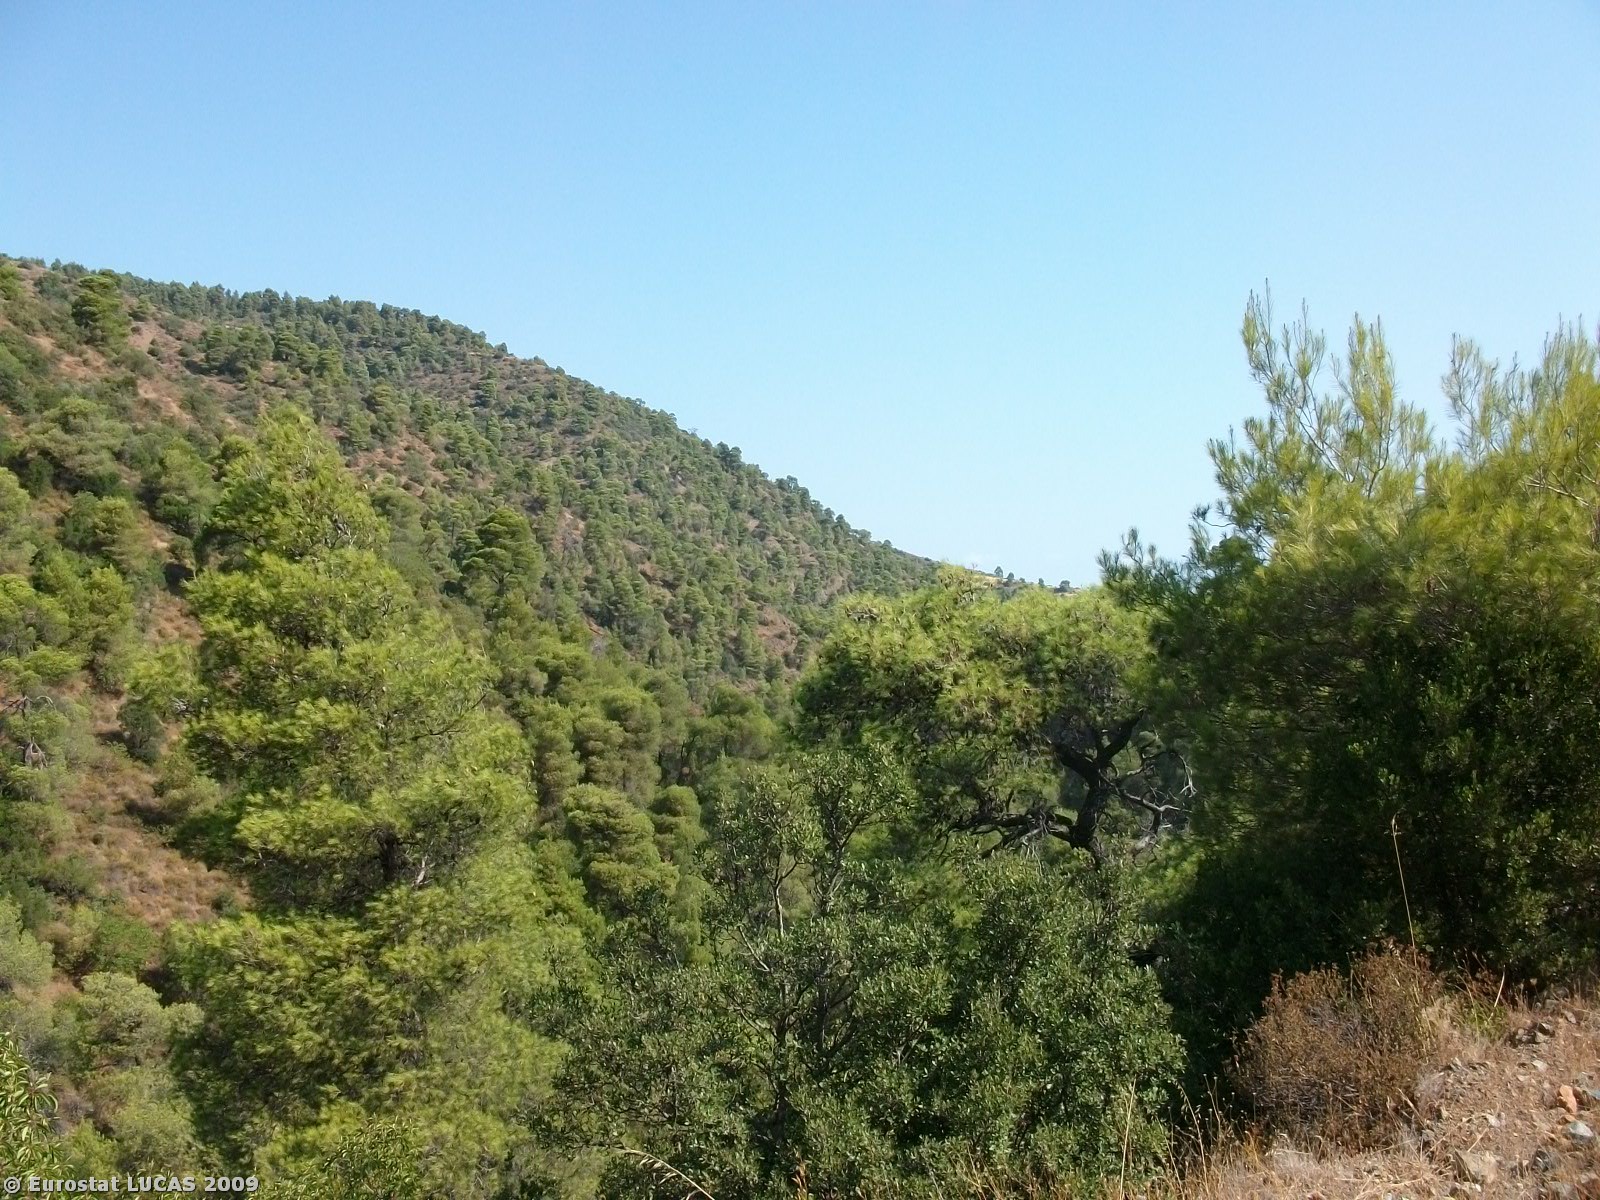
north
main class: Shrubland
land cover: Shrubland with sparse tree cover
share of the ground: 50 - 75 %
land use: Unused
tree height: < 5 m
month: August
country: GR
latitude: 38.5933
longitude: 23.1290
